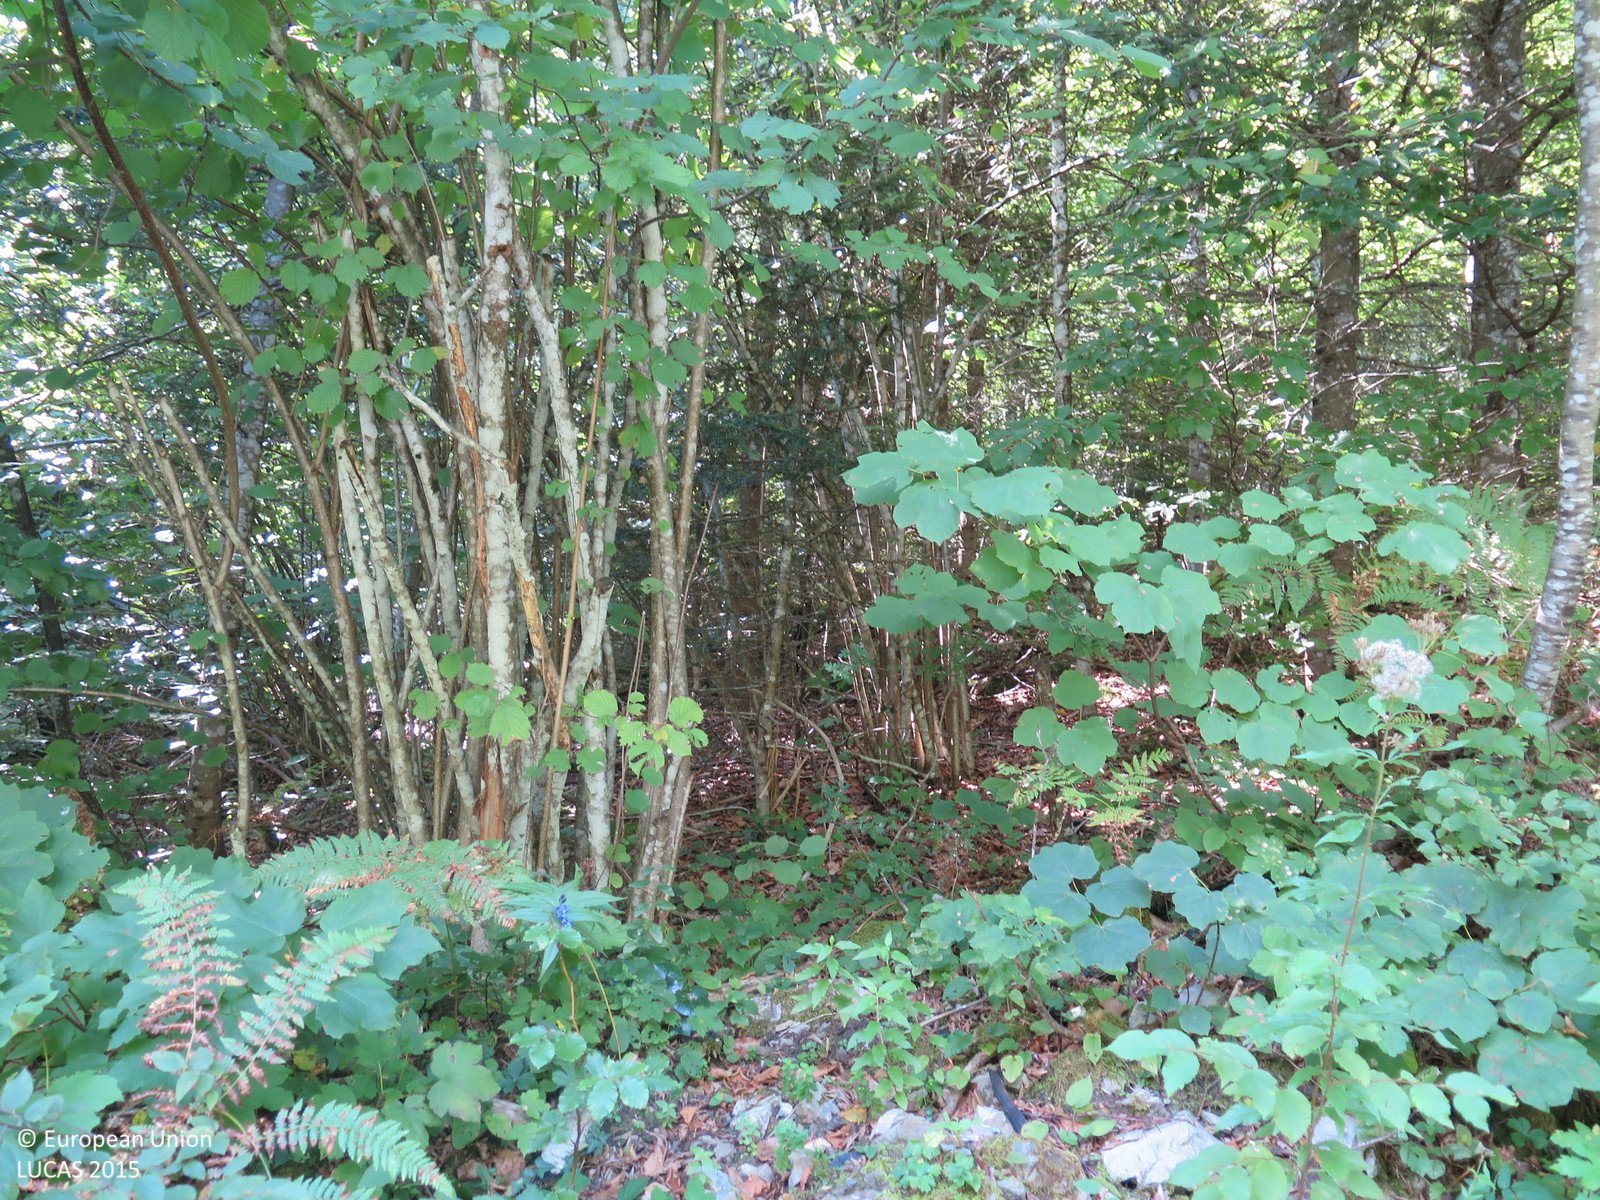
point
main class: Woodland
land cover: Broadleaved woodland
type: mountainous beech forest
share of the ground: > 75 %
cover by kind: broadleaved forest trees 90 %, herbaceous plants 5 %, unconsolidated bare surface 5 %
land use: Forestry
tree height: > 5 m
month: September
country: HR
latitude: 45.5252
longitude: 14.7200
